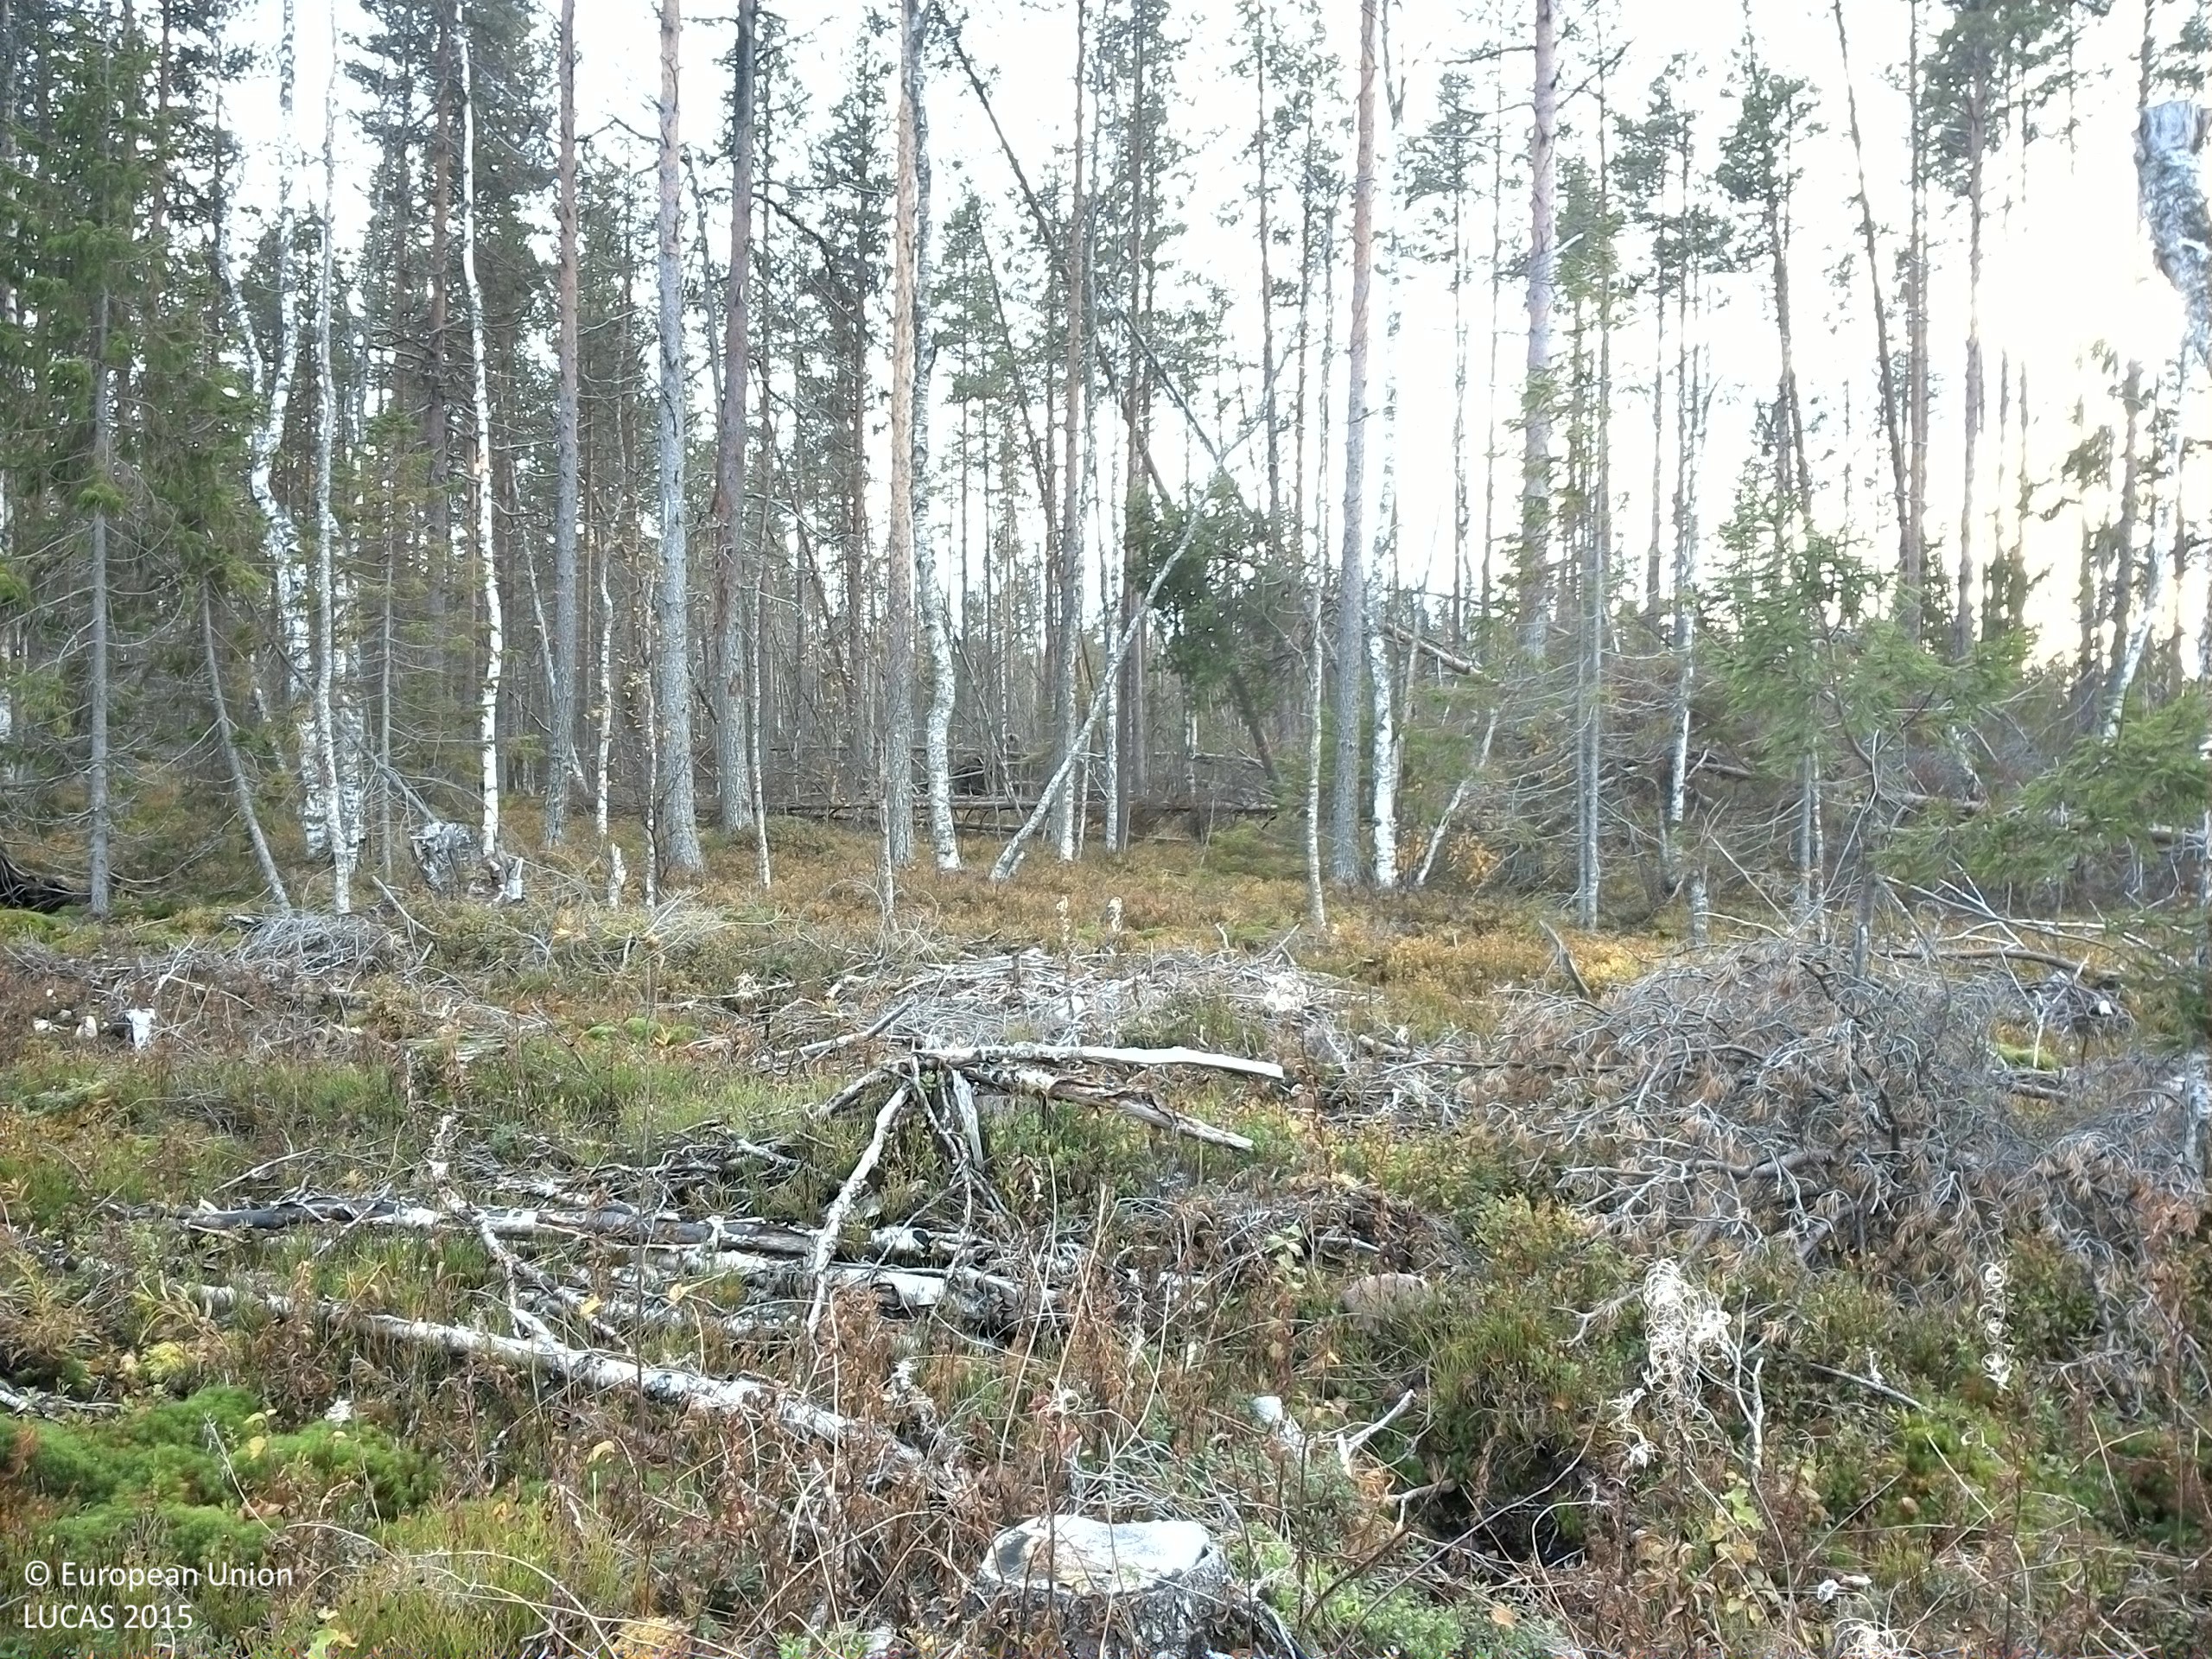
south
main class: Shrubland
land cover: Shrubland without tree cover
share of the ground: 25 - 50 %
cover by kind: shrubs 45 %, lichens and mosses 35 %, herbaceous plants 20 %
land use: Forestry
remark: Clear cut
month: October
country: SE
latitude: 64.0893
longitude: 15.8991
